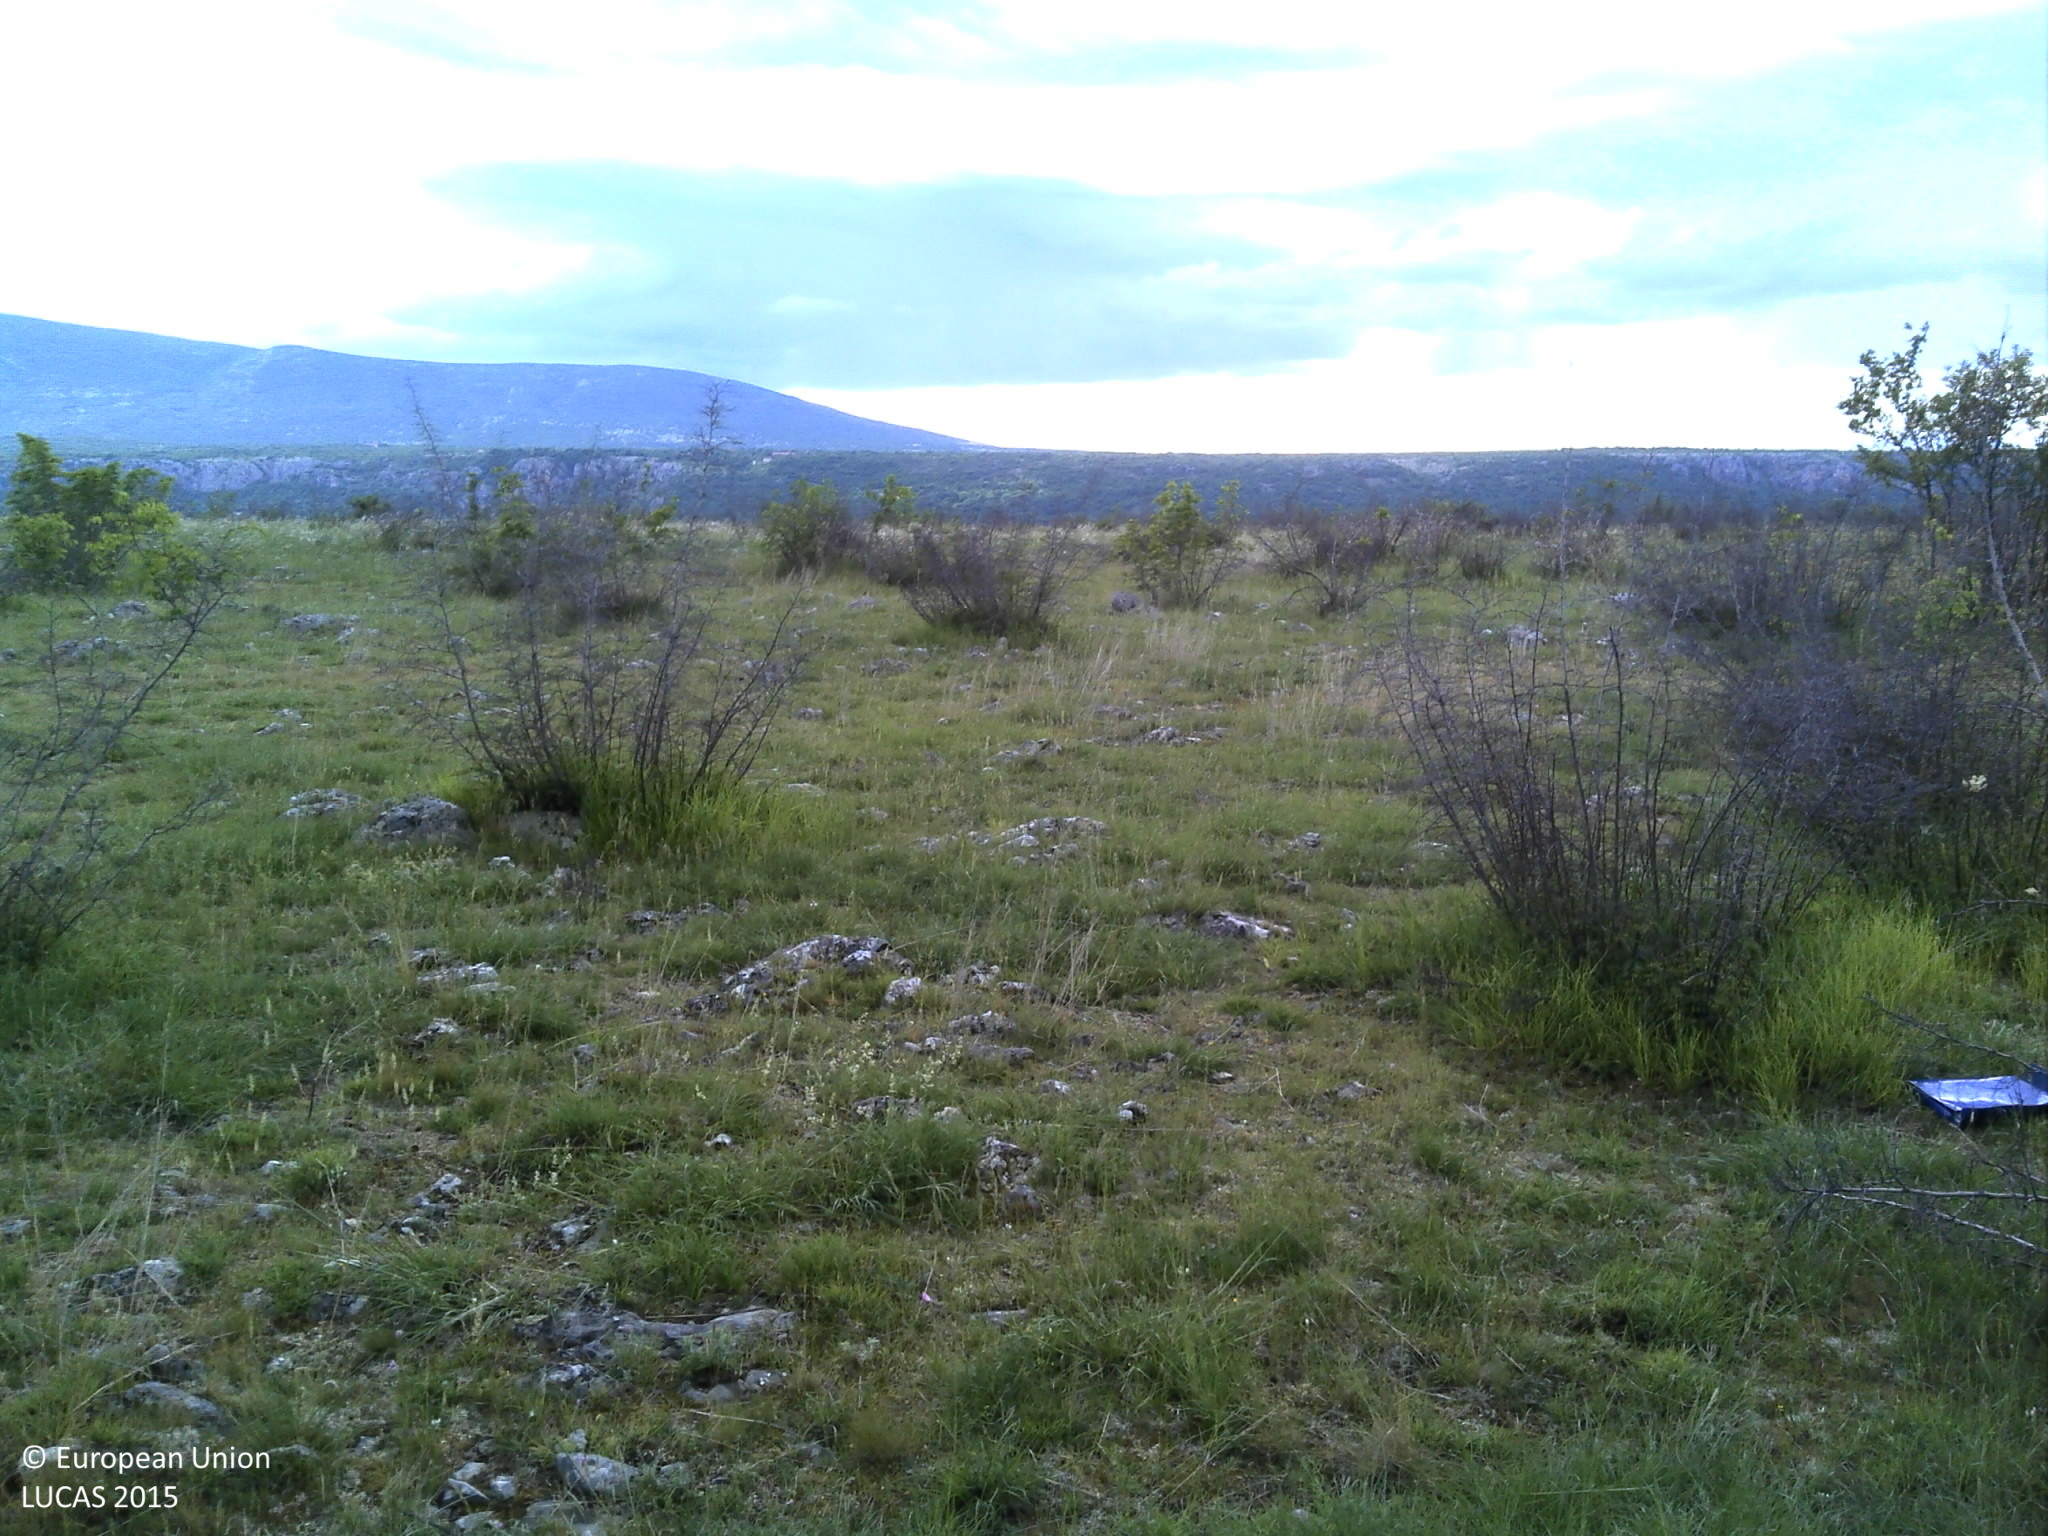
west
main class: Shrubland
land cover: Shrubland without tree cover
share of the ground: 10 - 25 %
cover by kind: herbaceous plants 75 %, shrubs 15 %, consolidated bare surface 5 %, unconsolidated bare surface 5 %
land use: Semi-natural and natural areas not in use
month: May
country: HR
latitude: 43.9819
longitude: 16.2384
